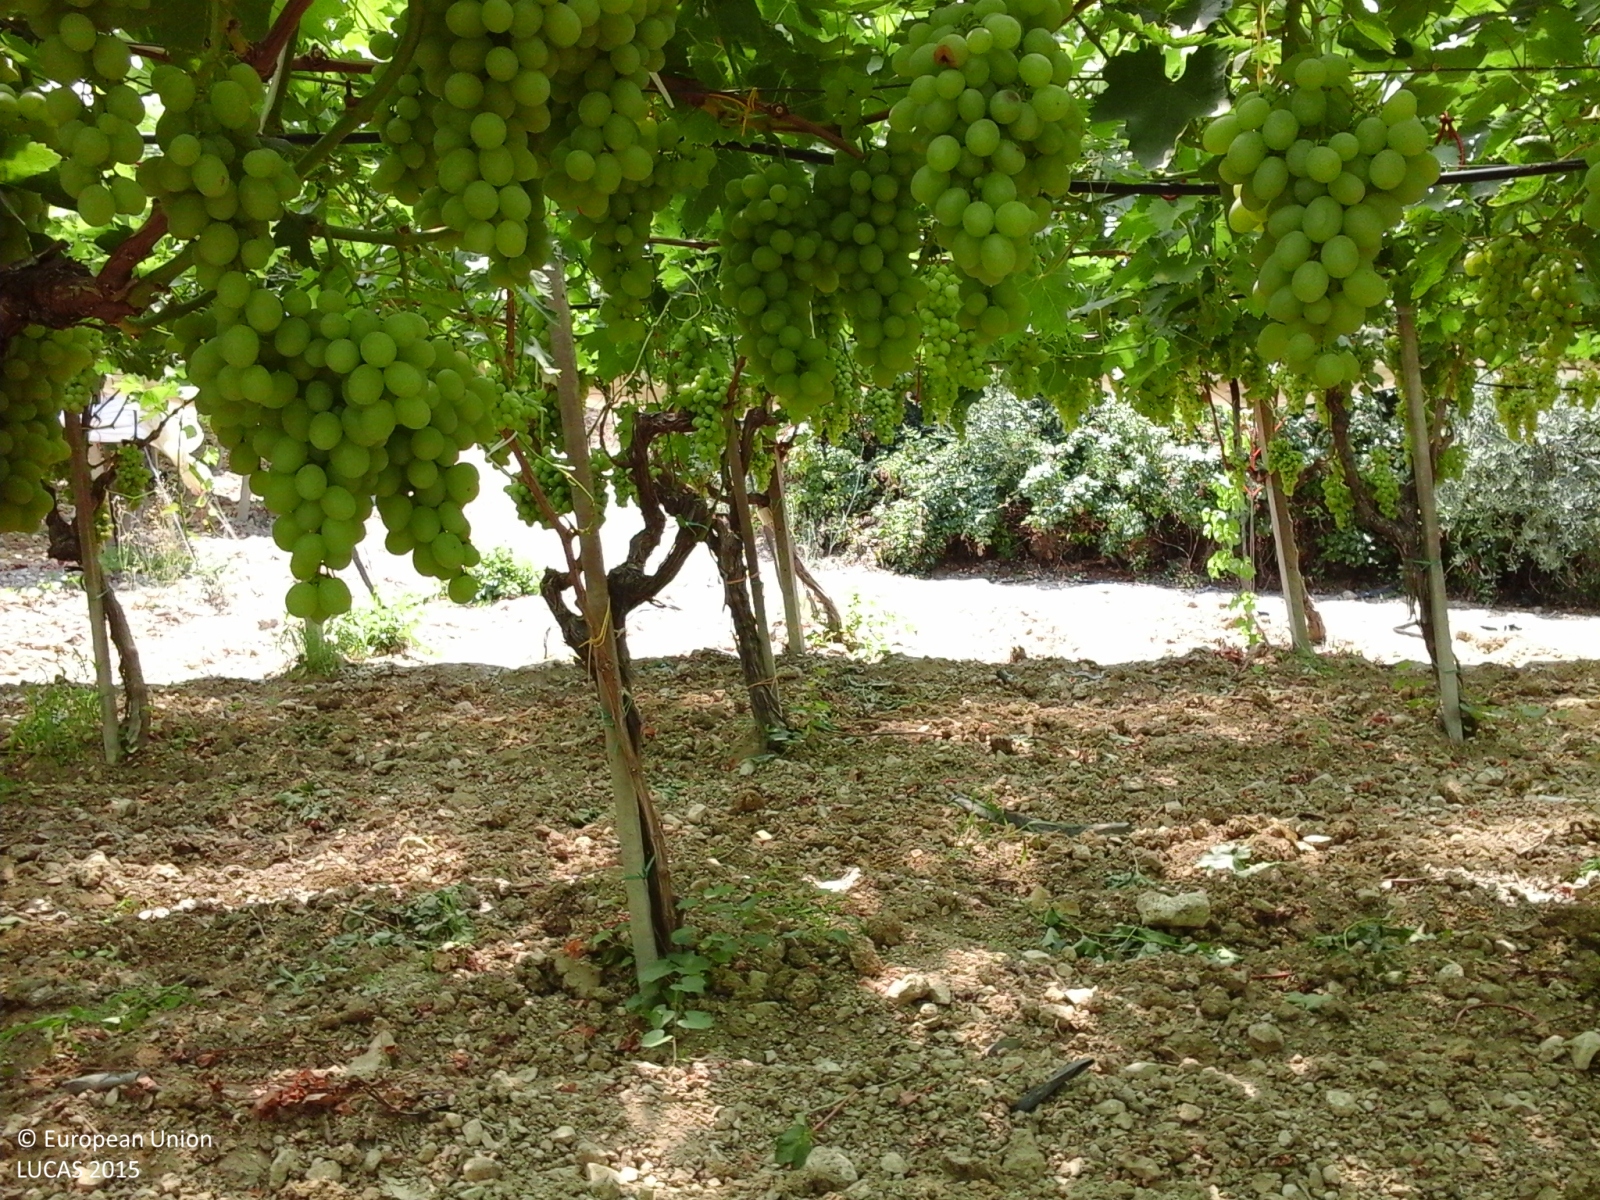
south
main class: Cropland
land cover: Vineyards
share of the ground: > 75 %
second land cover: Other bare soil
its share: > 75 %
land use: Agriculture (excluding fallow land and kitchen gardens)
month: July
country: IT
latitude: 37.1632
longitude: 13.7875
